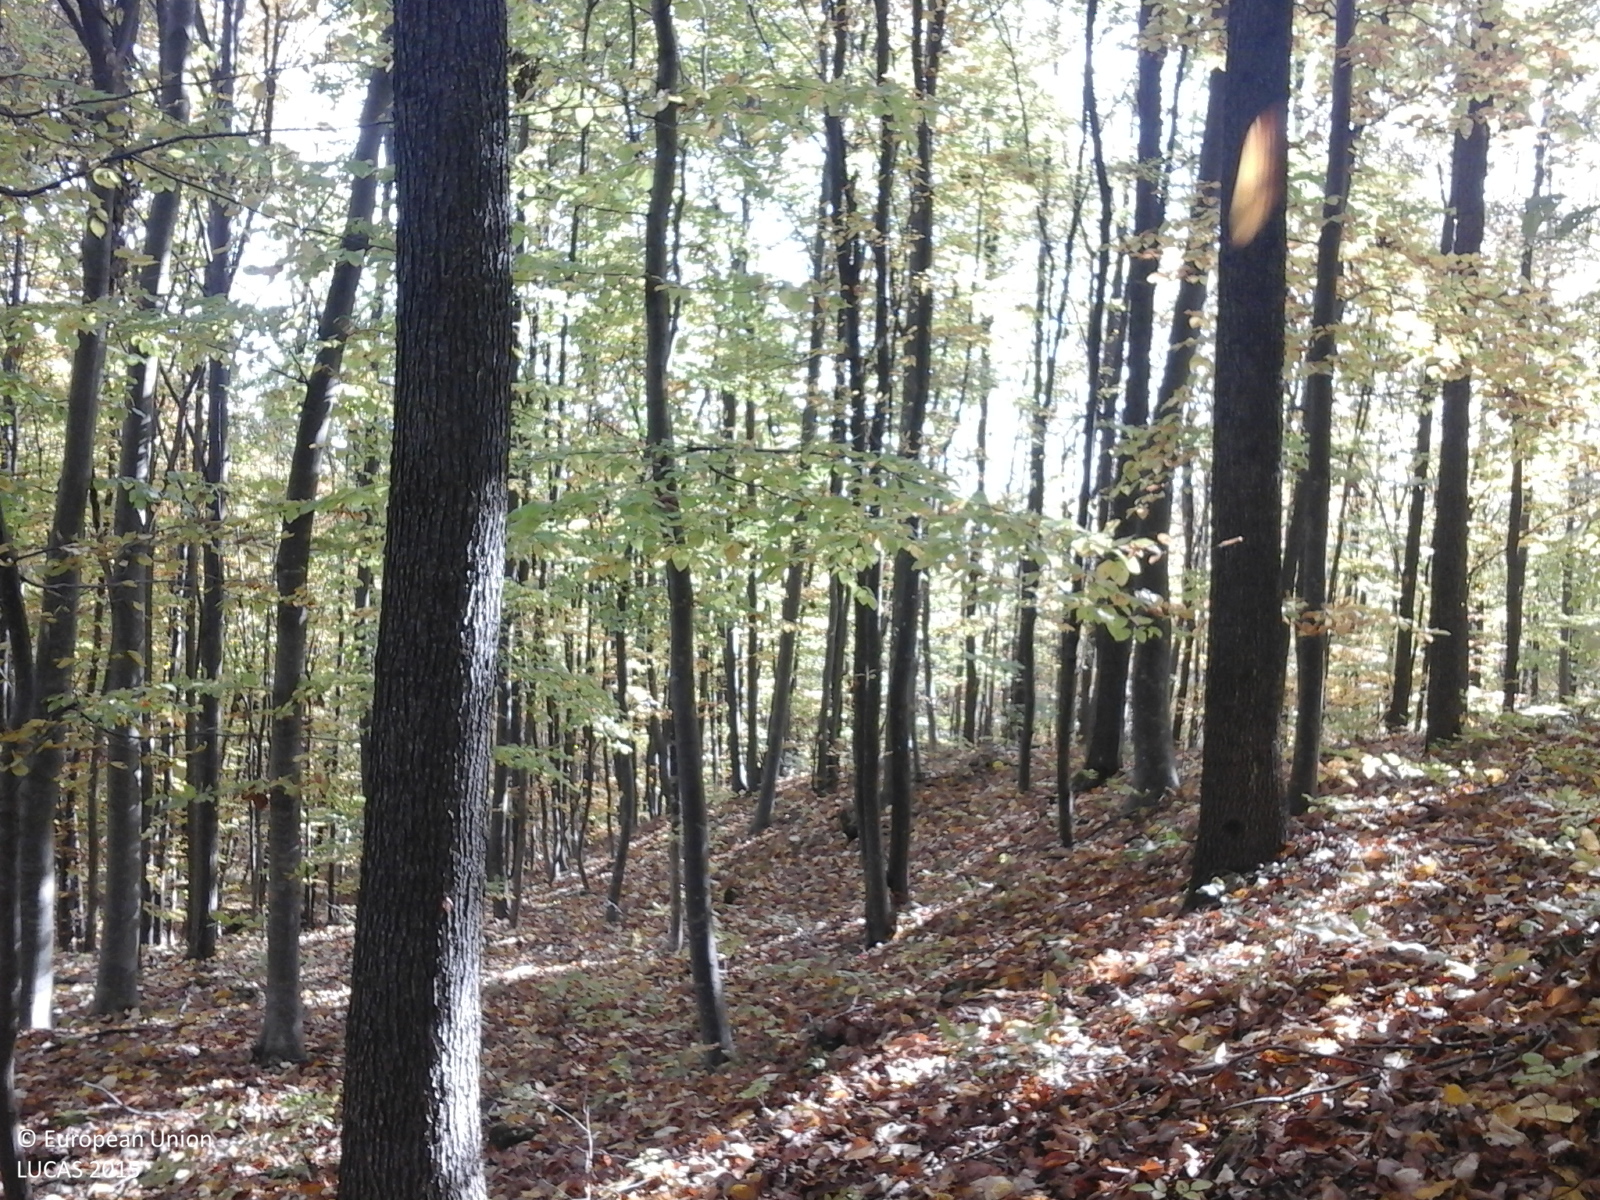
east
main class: Woodland
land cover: Broadleaved woodland
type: beech forest
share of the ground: > 75 %
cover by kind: broadleaved forest trees 100 %
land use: Forestry
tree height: > 5 m
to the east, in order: Broadleaved woodland; Rivers and streams; Broadleaved woodland; Rivers and streams; Broadleaved woodland; Fences; Grassland with sparse tree/shrub cover
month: October
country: RO
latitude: 45.1691
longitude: 26.4973
